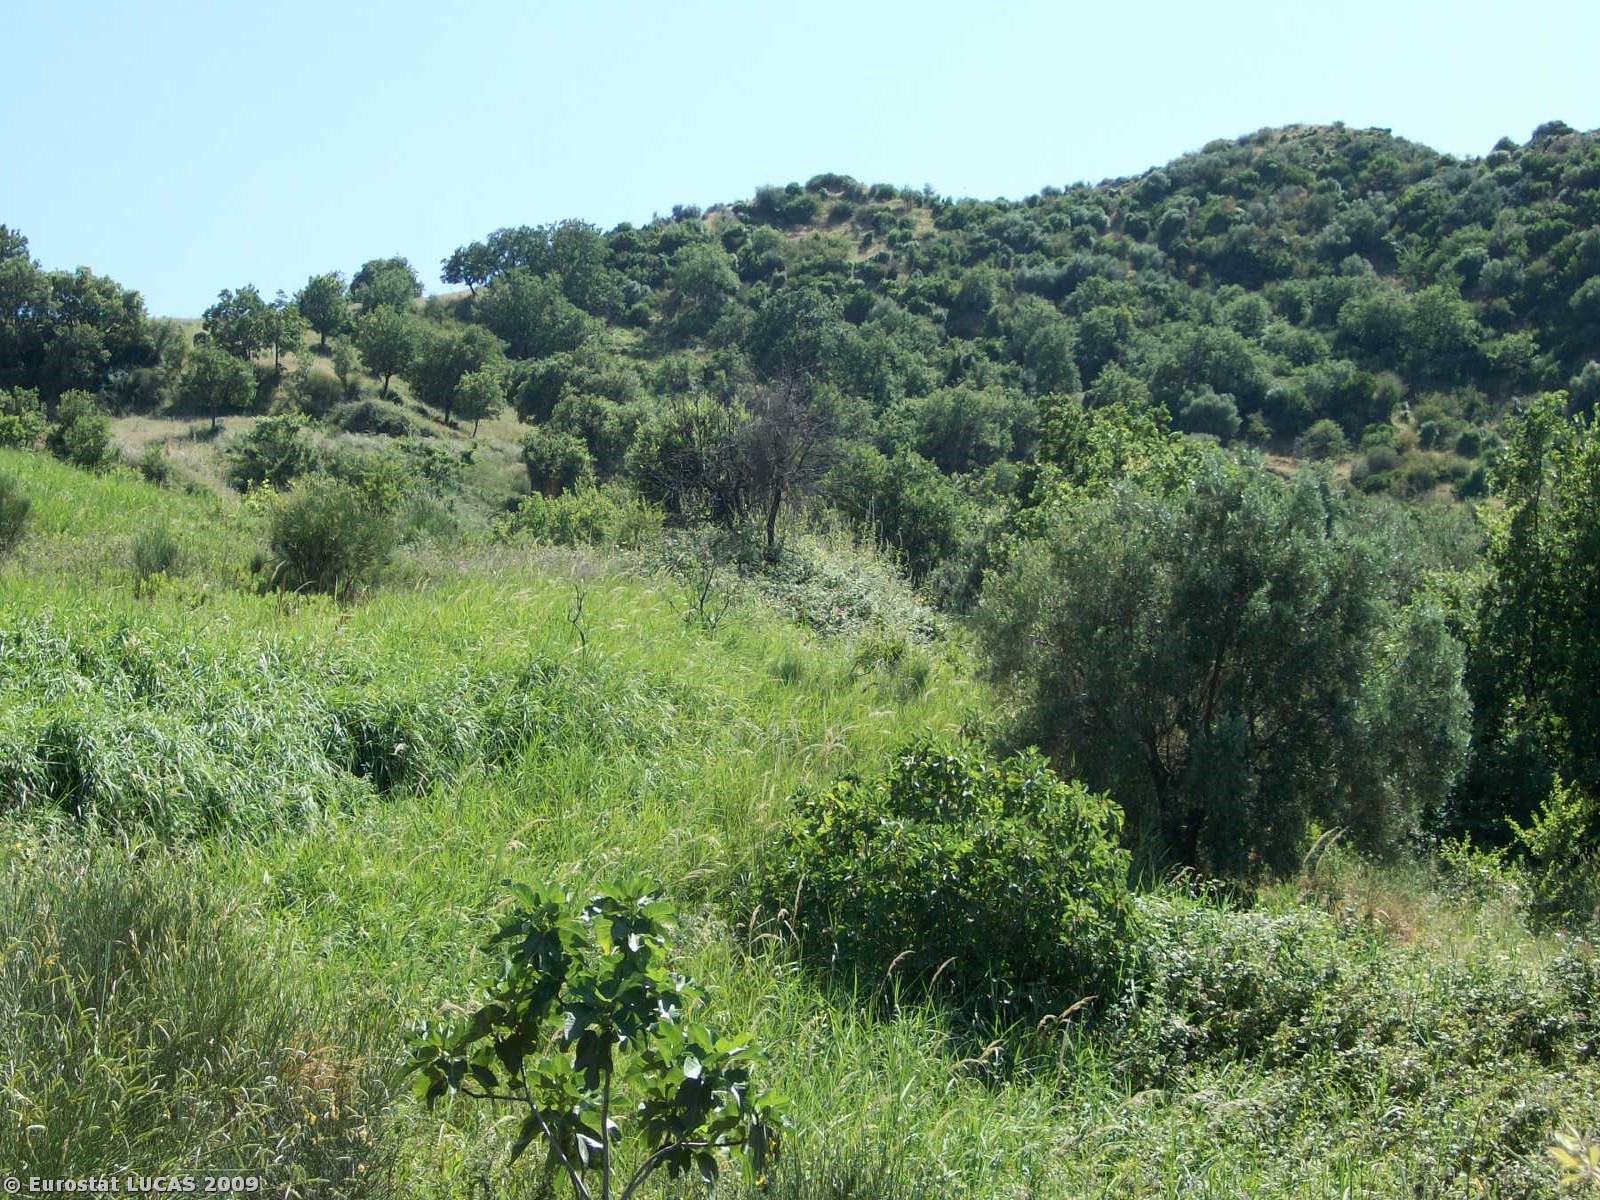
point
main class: Shrubland
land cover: Shrubland with sparse tree cover
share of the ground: > 75 %
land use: Unused
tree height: > 5 m
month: June
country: IT
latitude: 39.4966
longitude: 16.9115
